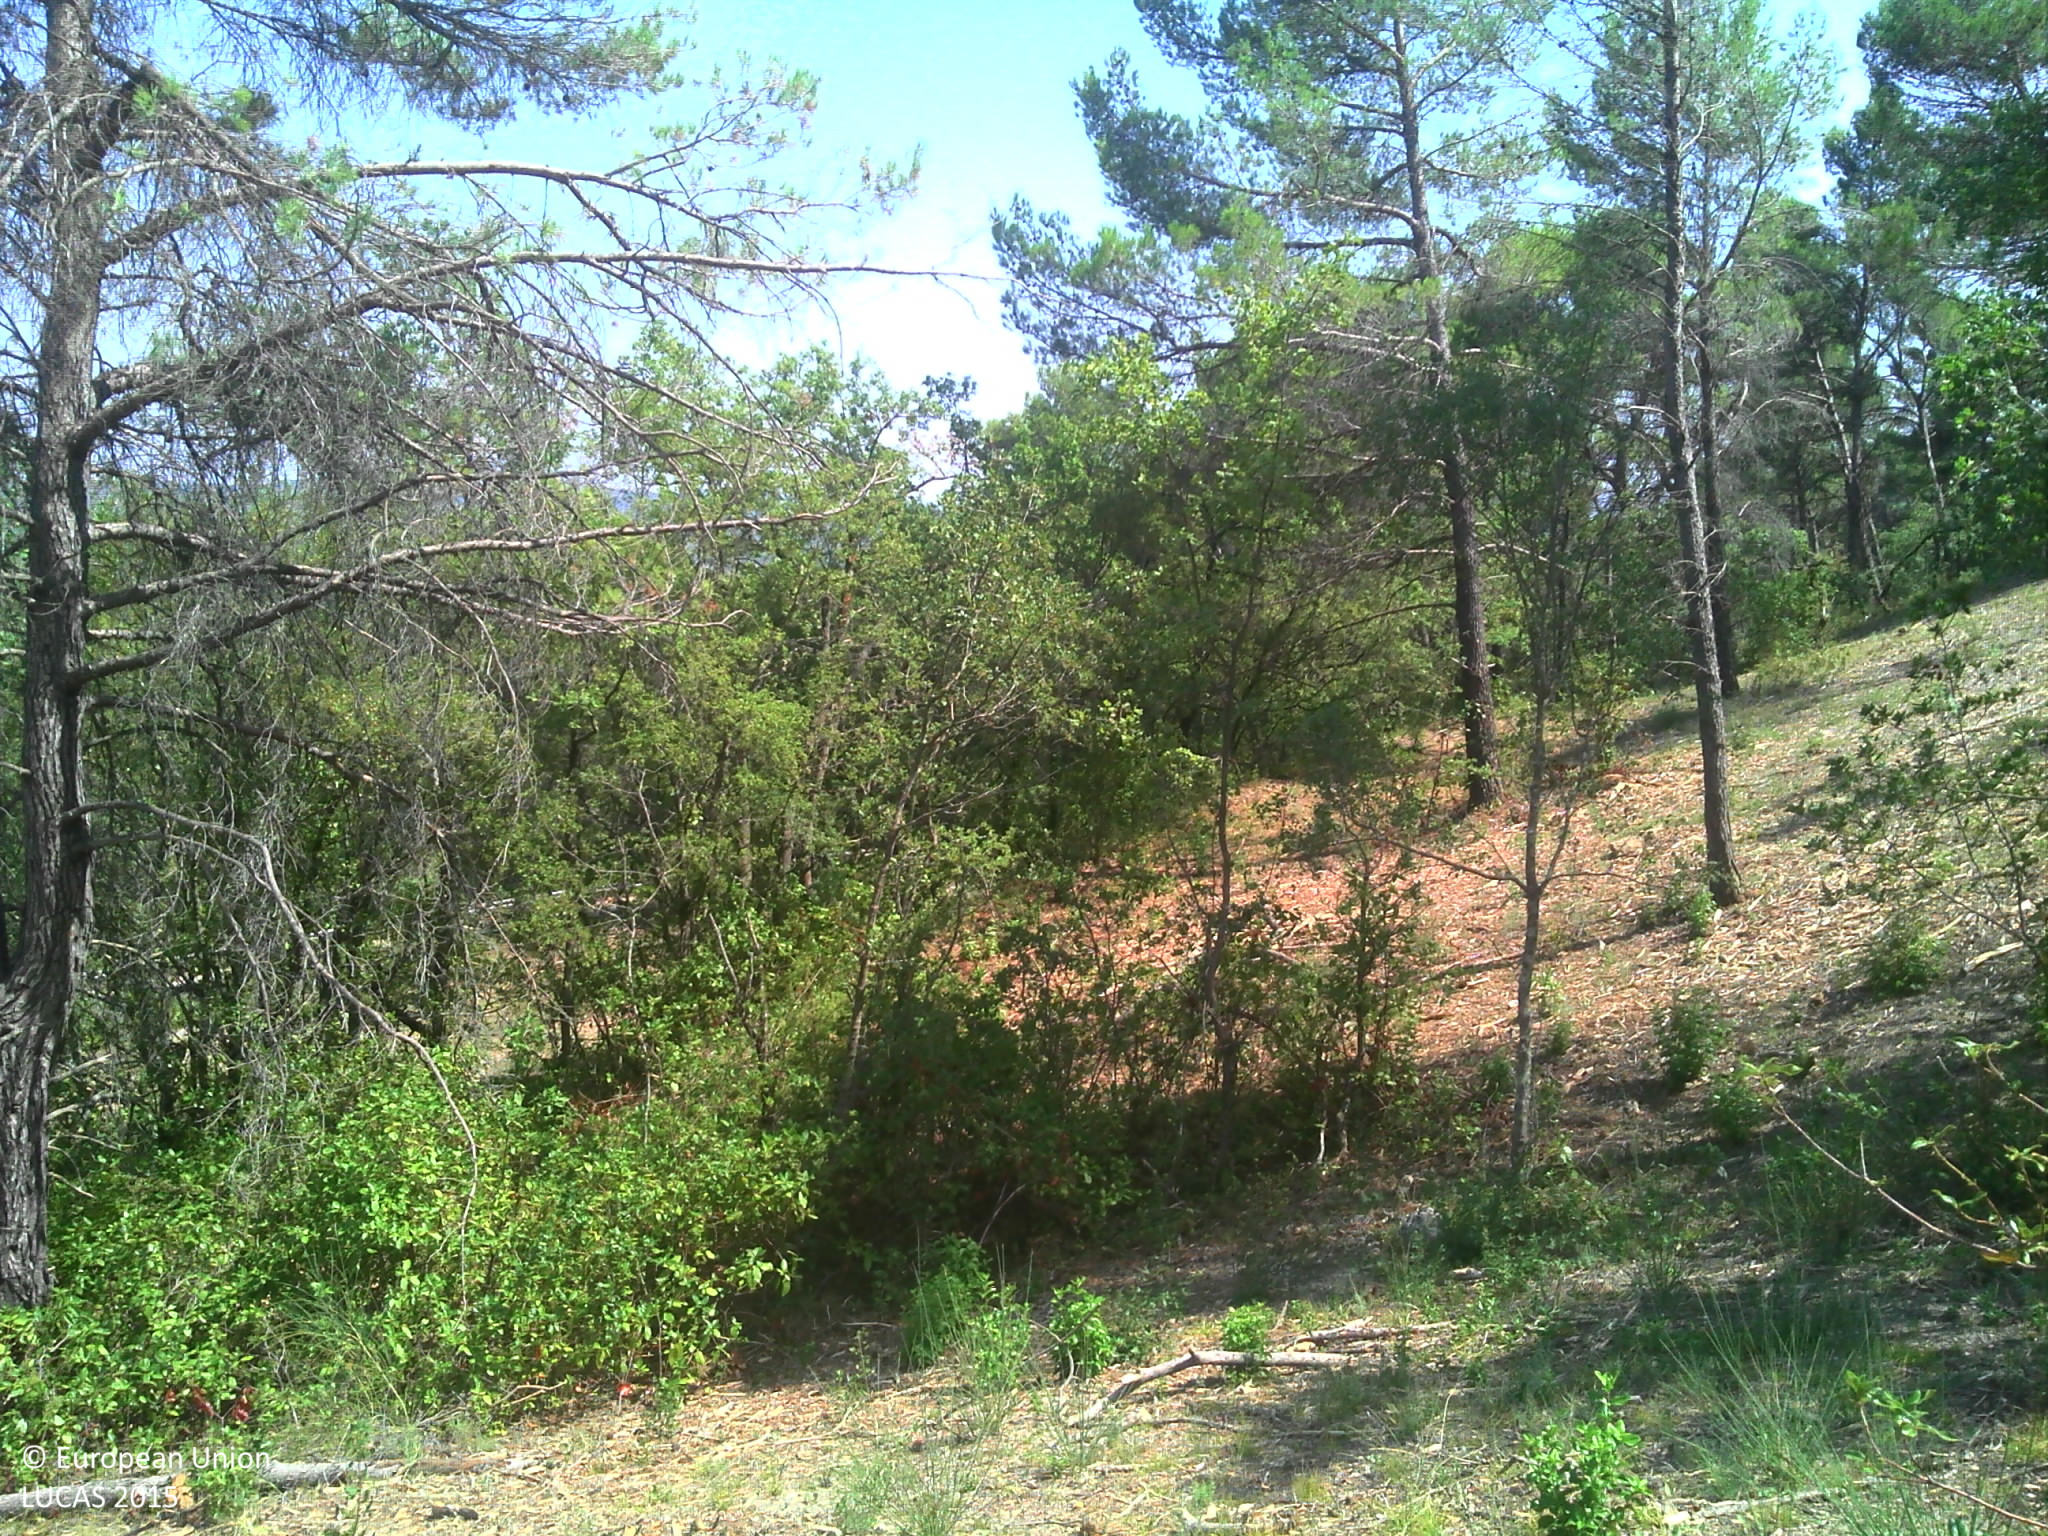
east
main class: Grassland
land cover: Spontaneously vegetated surfaces
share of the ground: 25 - 50 %
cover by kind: unconsolidated bare surface 70 %, herbaceous plants 25 %, shrubs 5 %
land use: Forestry
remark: Clear cut
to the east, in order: Spontaneously vegetated surfaces; Pine dominated coniferous woodland; Ditches and canals; Paved roads, cycling and walking lanes; Fences; Pine dominated mixed woodland; Tracks; Pine dominated coniferous woodland; Tracks; Pine dominated coniferous woodland; Broadleaved woodland
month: August
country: FR
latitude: 43.6190
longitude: 5.4616
